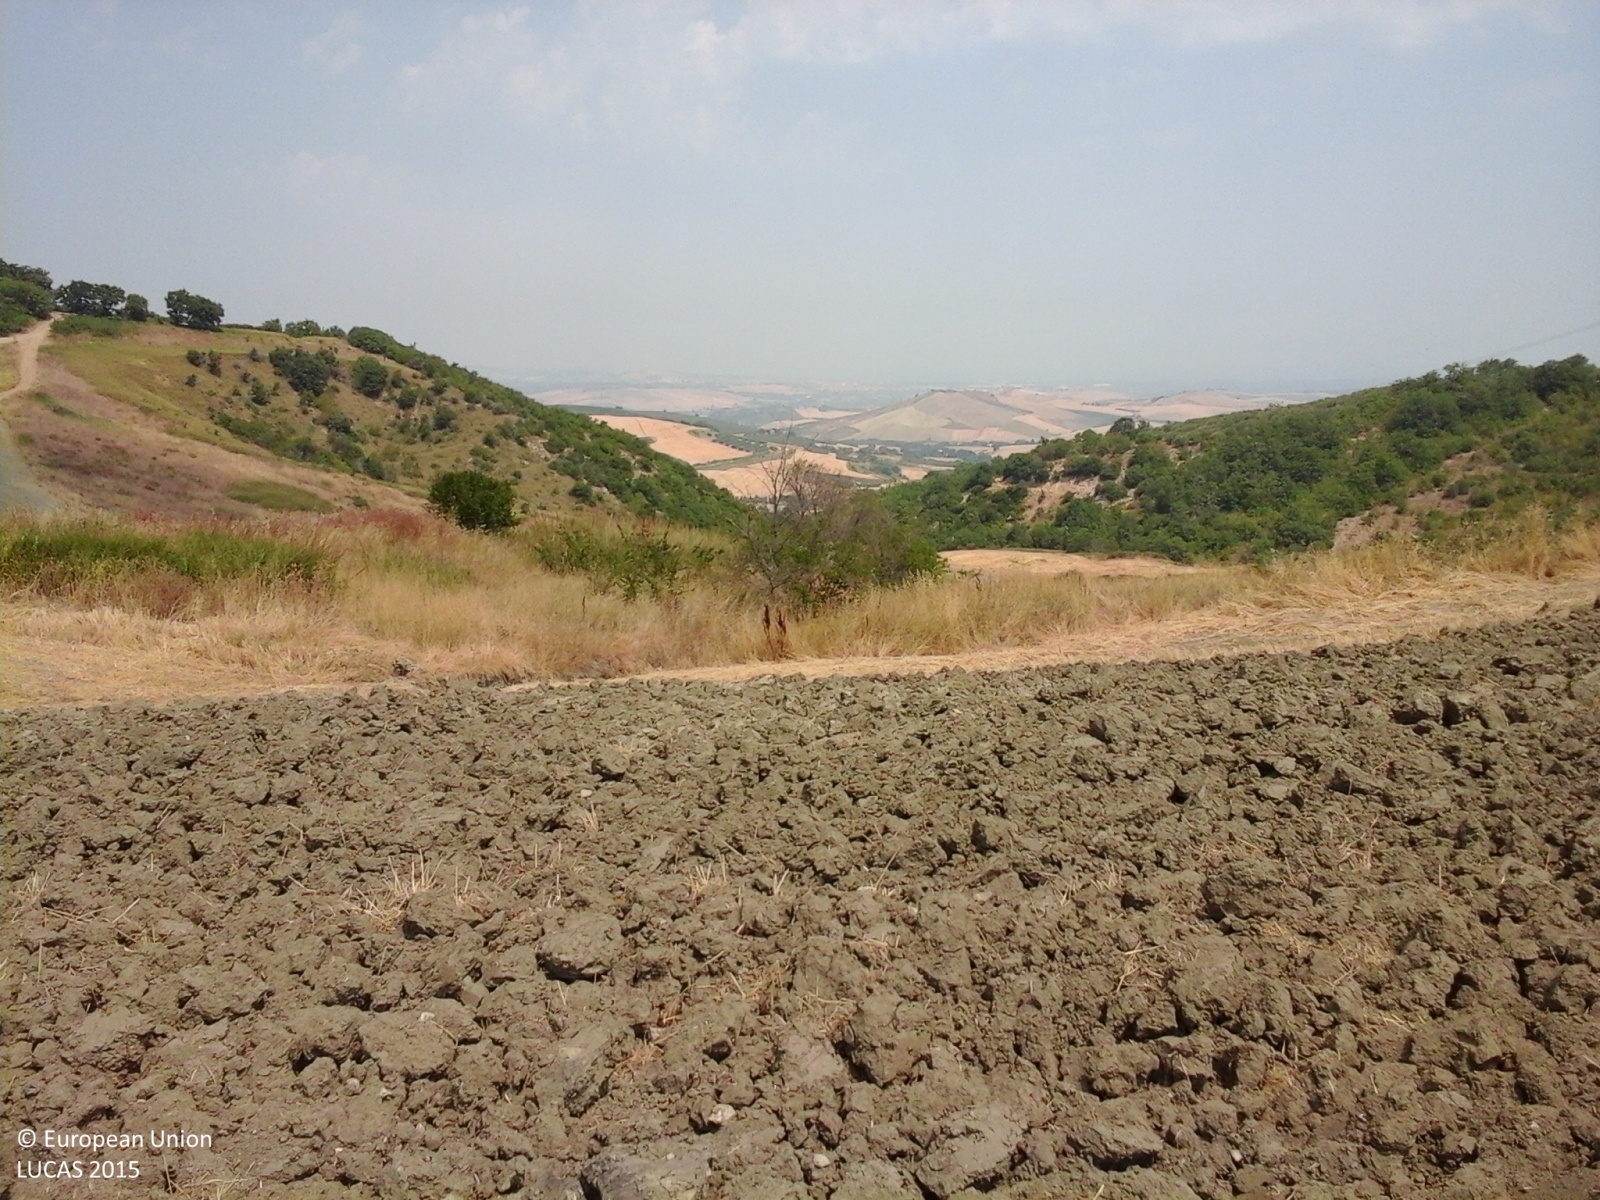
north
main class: Cropland
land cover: Durum wheat
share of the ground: > 75 %
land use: Agriculture (excluding fallow land and kitchen gardens)
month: August
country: IT
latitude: 41.9467
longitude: 14.7257
